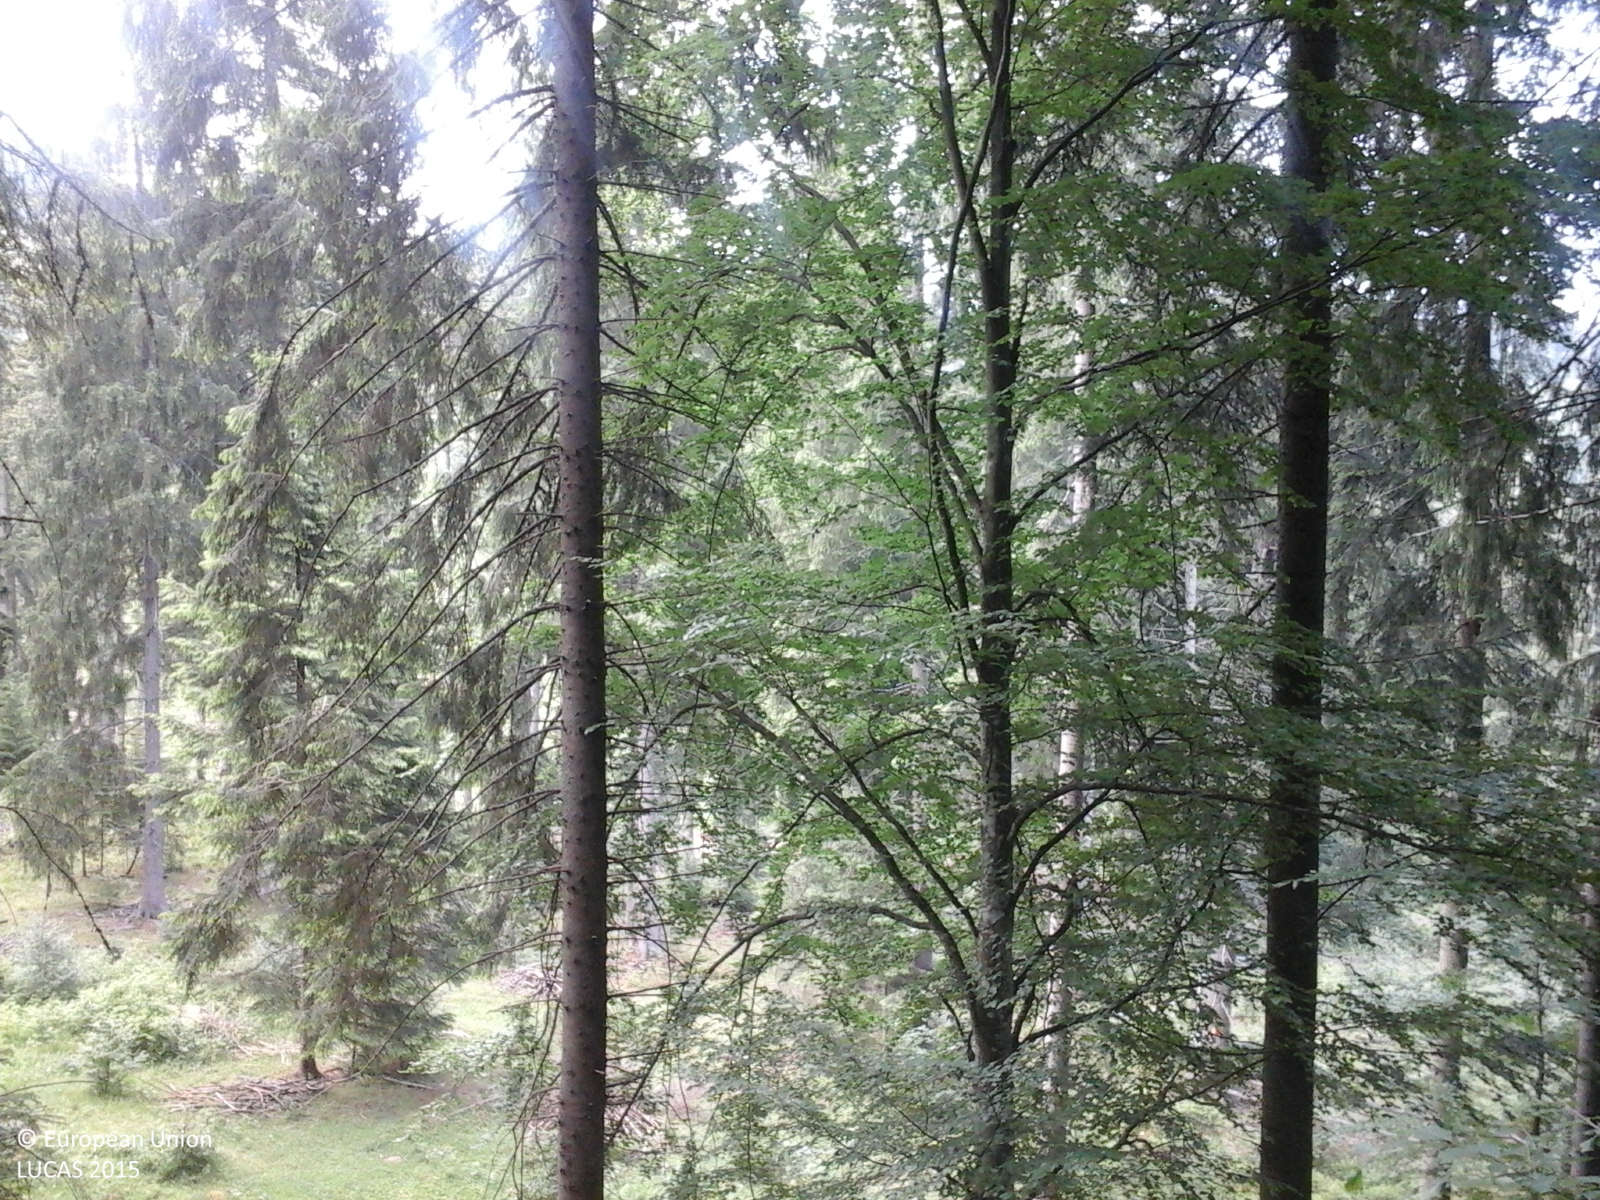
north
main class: Woodland
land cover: Other mixed woodland
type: alpine coniferous forest
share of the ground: > 75 %
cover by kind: coniferous forest trees 70 %, broadleaved forest trees 30 %
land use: Forestry
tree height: > 5 m
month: June
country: RO
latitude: 47.5742
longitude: 25.3886
